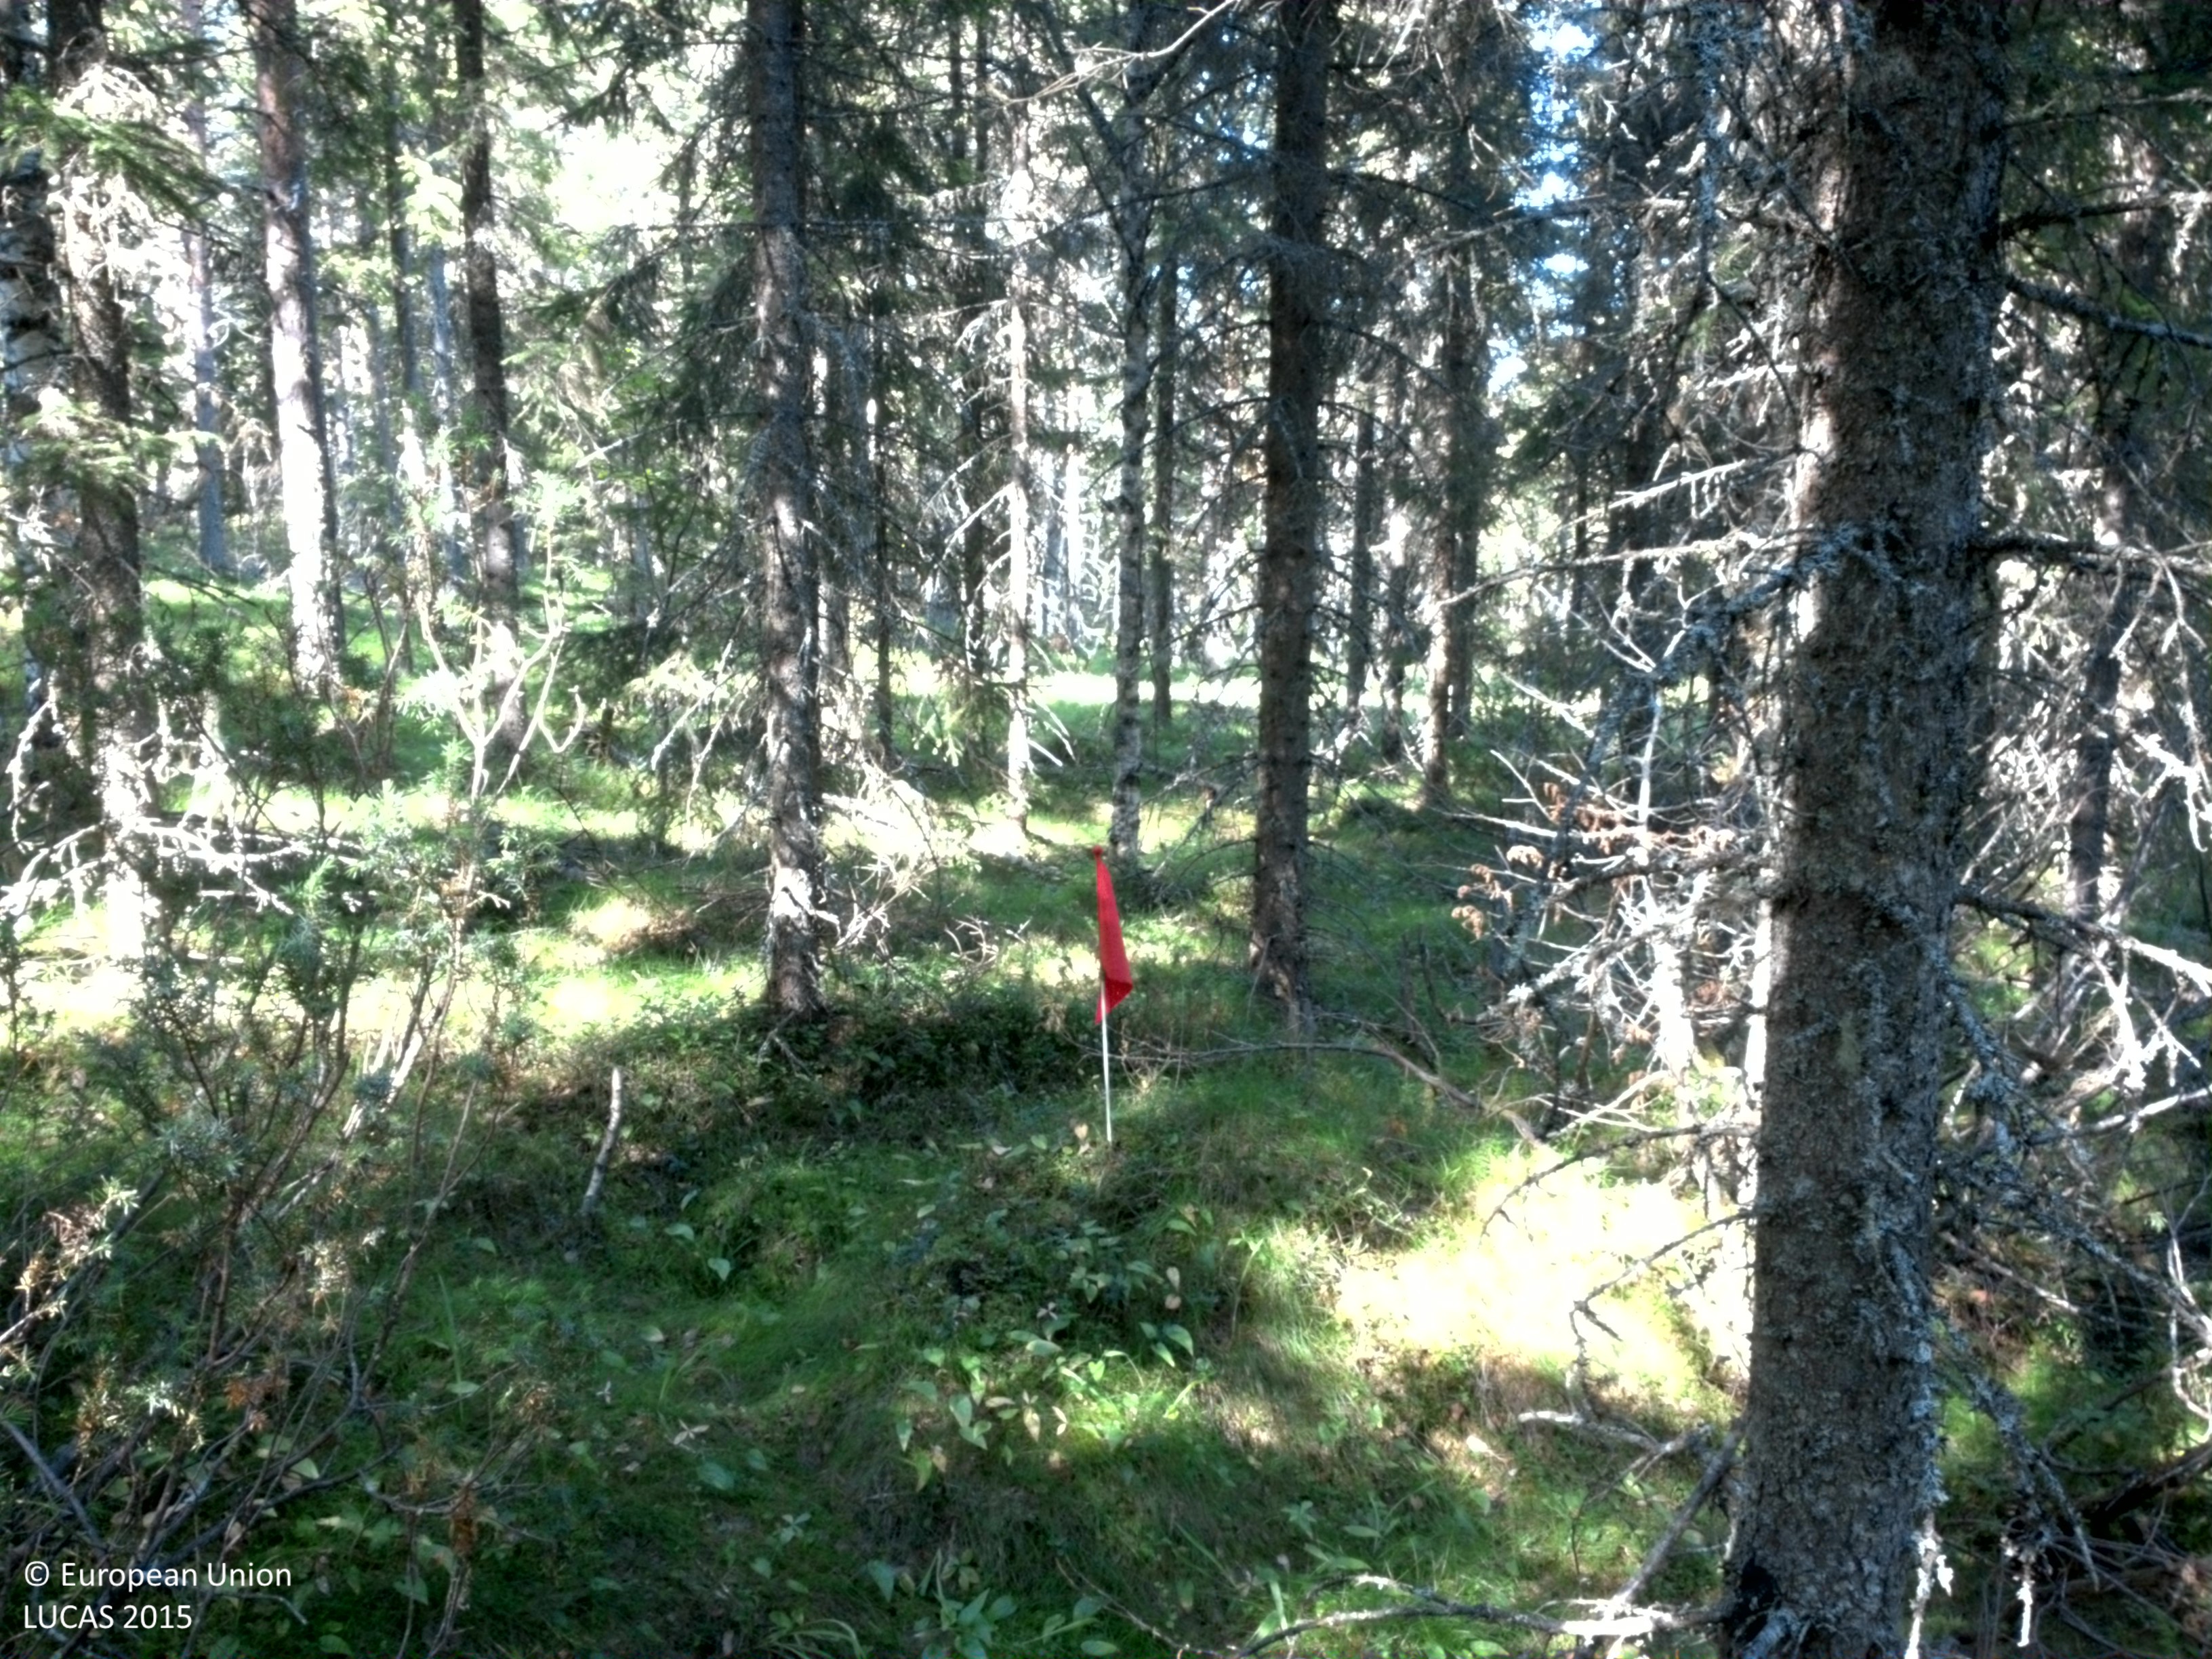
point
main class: Woodland
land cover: Spruce dominated coniferous woodland
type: boreal forest
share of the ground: 50 - 75 %
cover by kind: coniferous forest trees 60 %, herbaceous plants 20 %, shrubs 15 %, broadleaved forest trees 5 %
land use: Forestry
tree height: > 5 m
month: August
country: SE
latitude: 64.4872
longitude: 18.6878
